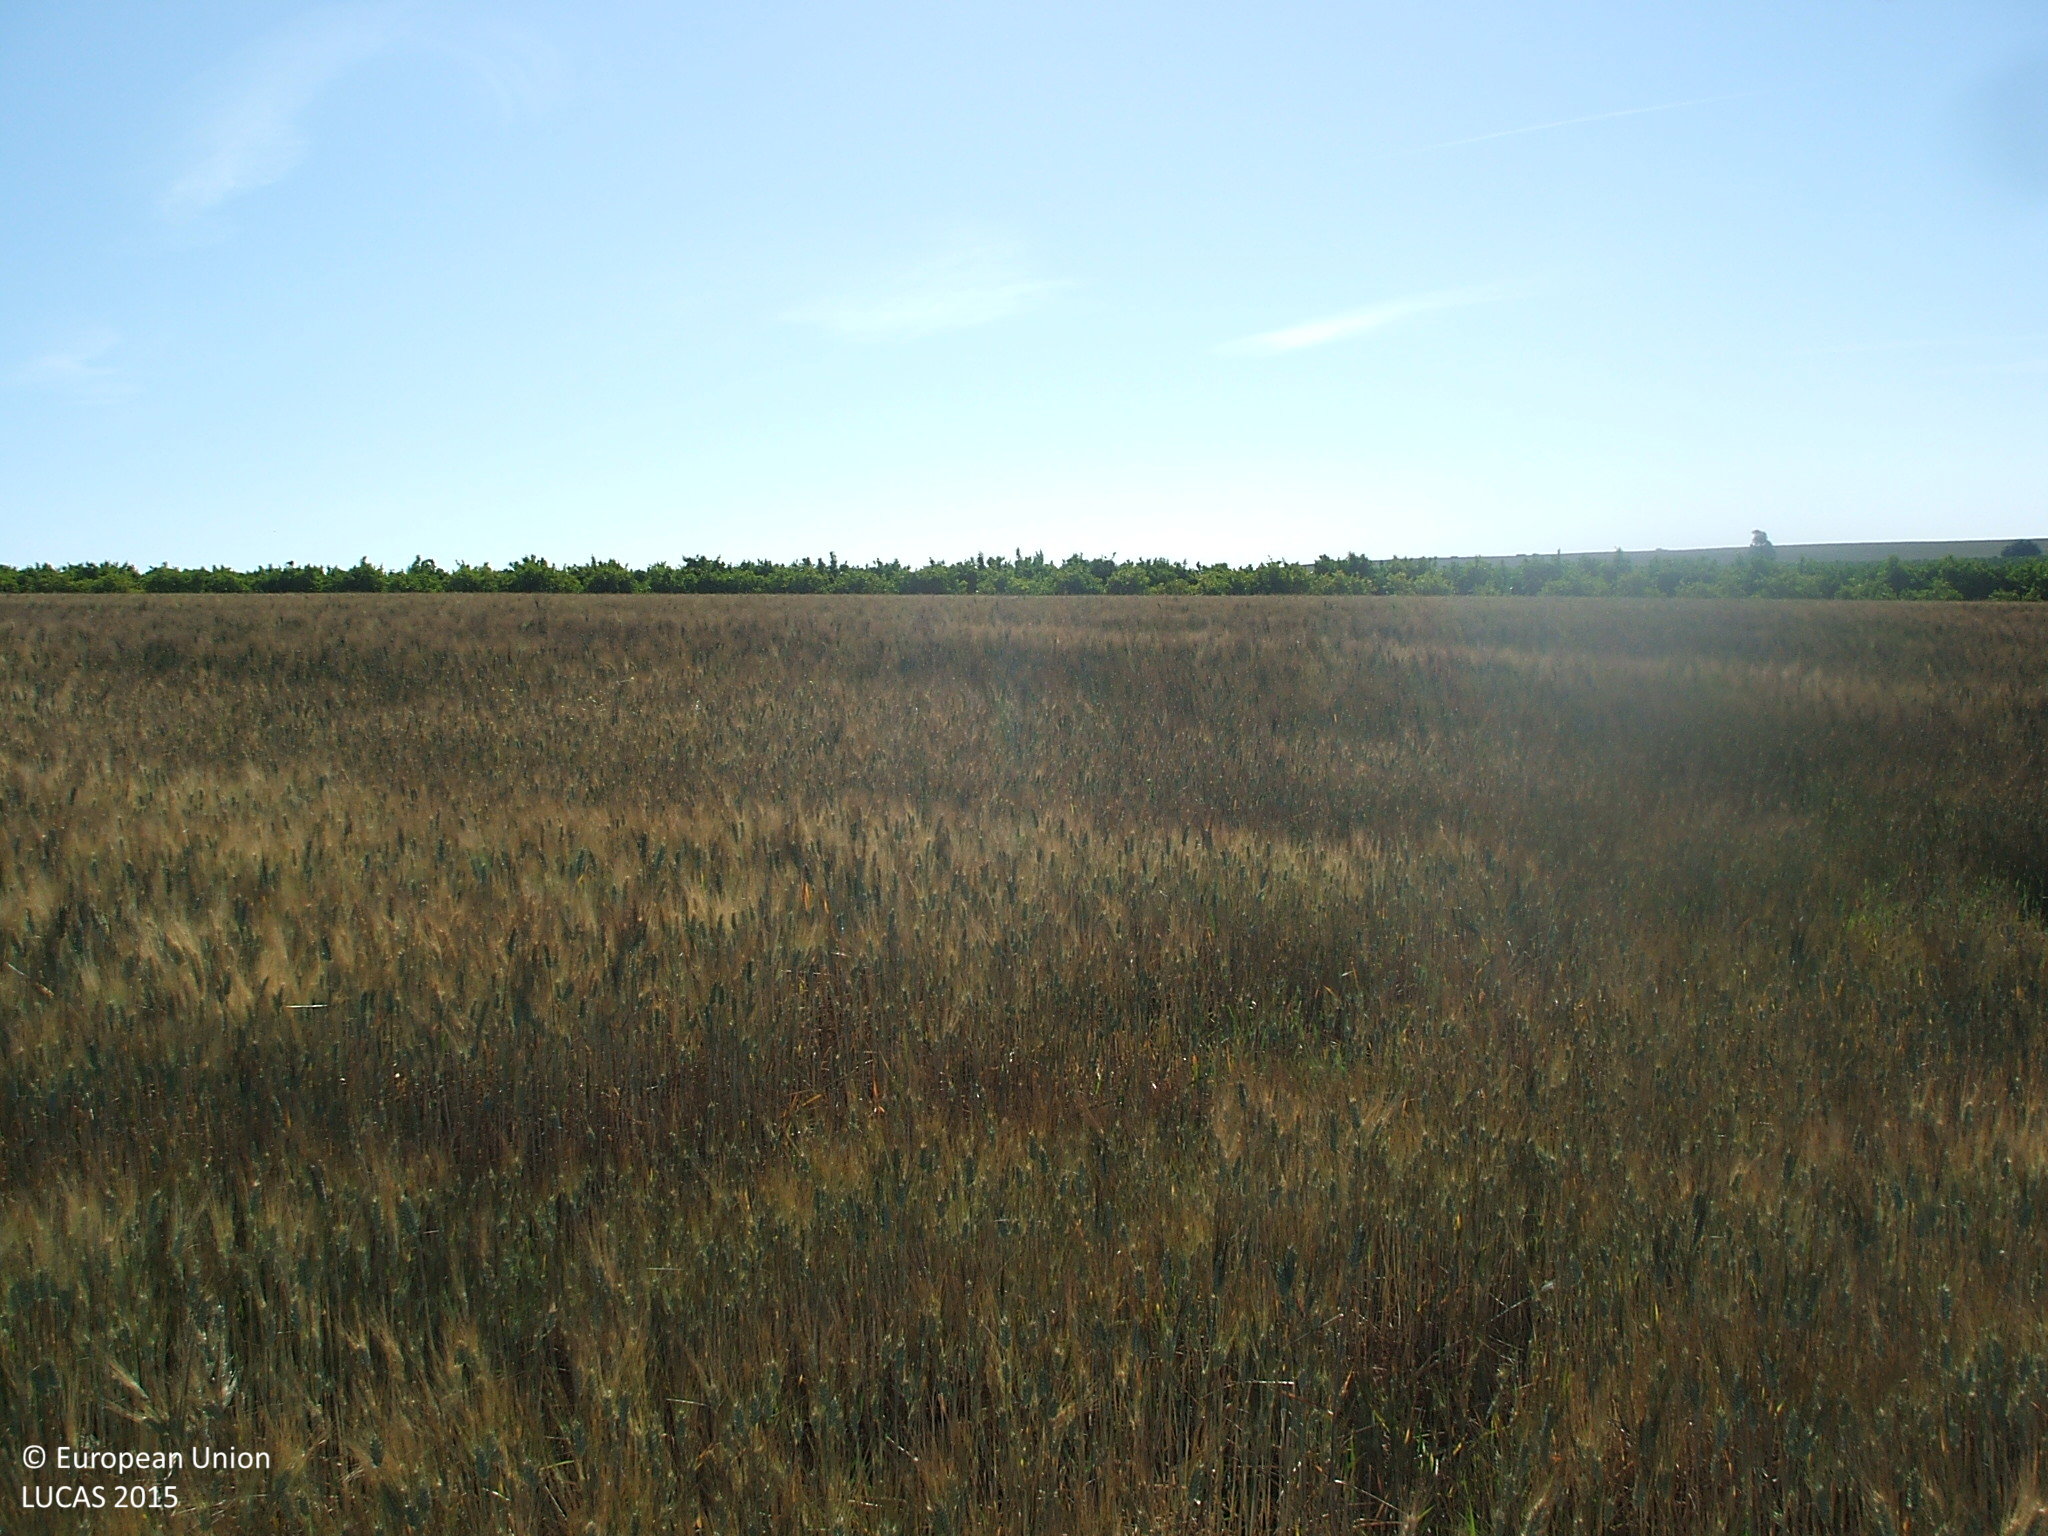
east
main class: Cropland
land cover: Common wheat
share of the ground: > 75 %
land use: Agriculture (excluding fallow land and kitchen gardens)
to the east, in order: Common wheat; Oranges
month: April
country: ES
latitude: 37.7268
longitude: -5.4634
